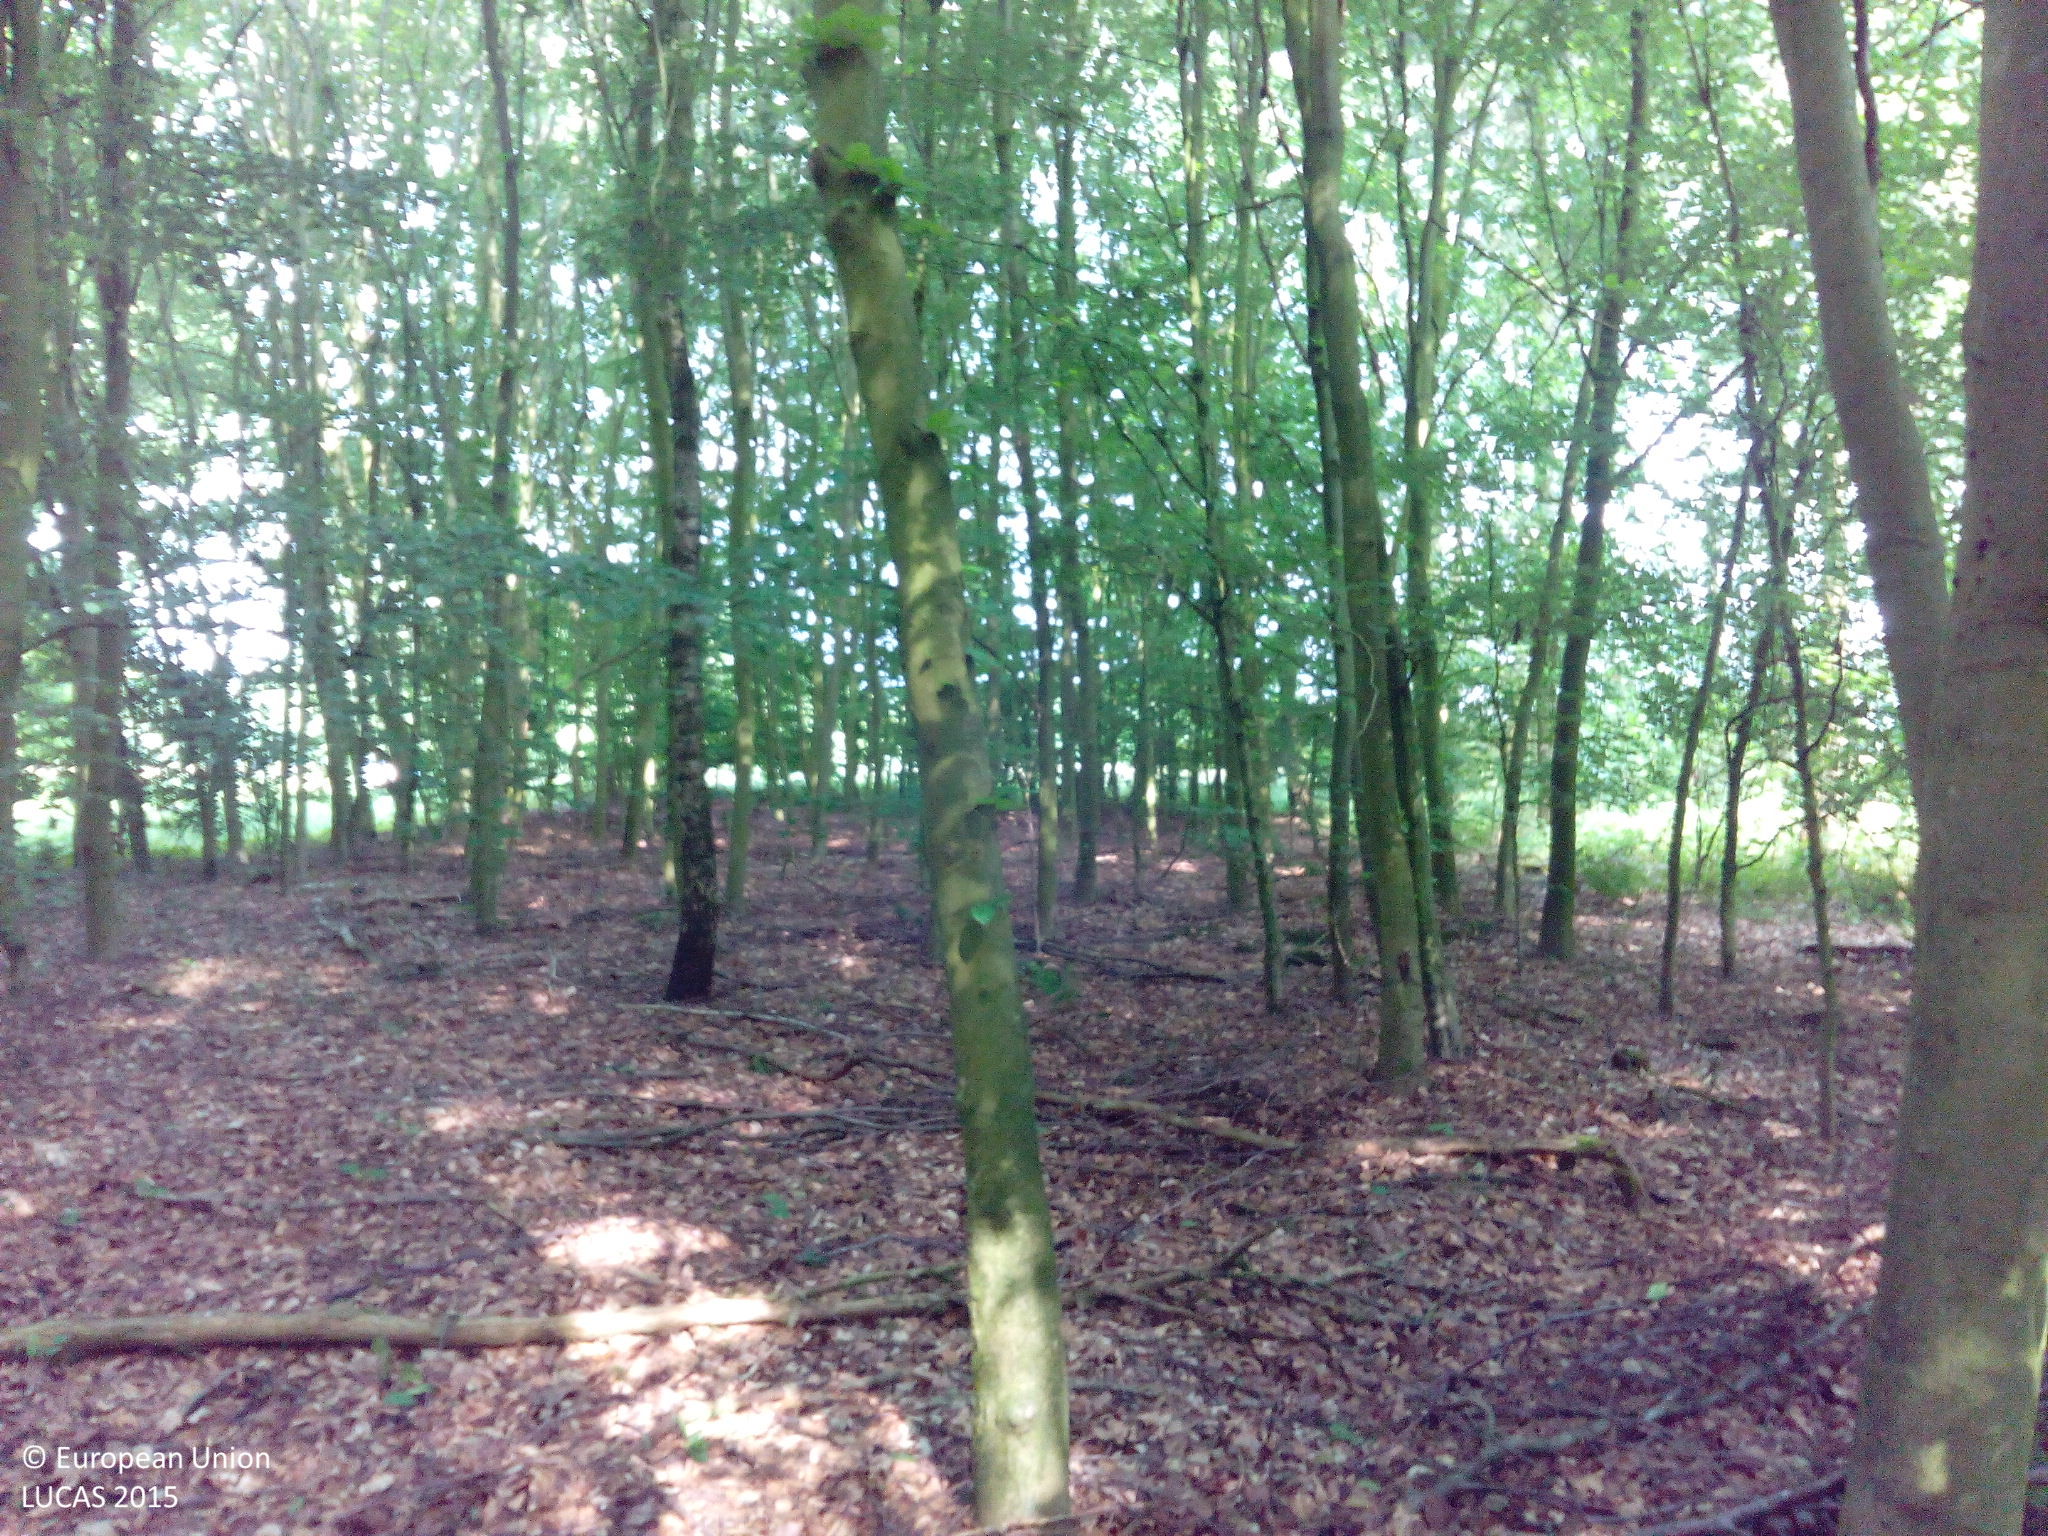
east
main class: Woodland
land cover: Broadleaved woodland
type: mesophytic deciduous forest
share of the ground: > 75 %
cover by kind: broadleaved forest trees 100 %
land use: Forestry
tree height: > 5 m
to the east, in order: Broadleaved woodland; Grass margins; Ditches and canals; Grassland without tree/shrub cover; Maize; Abandoned hedges; Electric lines; Grass margins; Paved roads, cycling and walking lanes
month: June
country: DE
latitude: 52.3324
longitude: 7.4616
